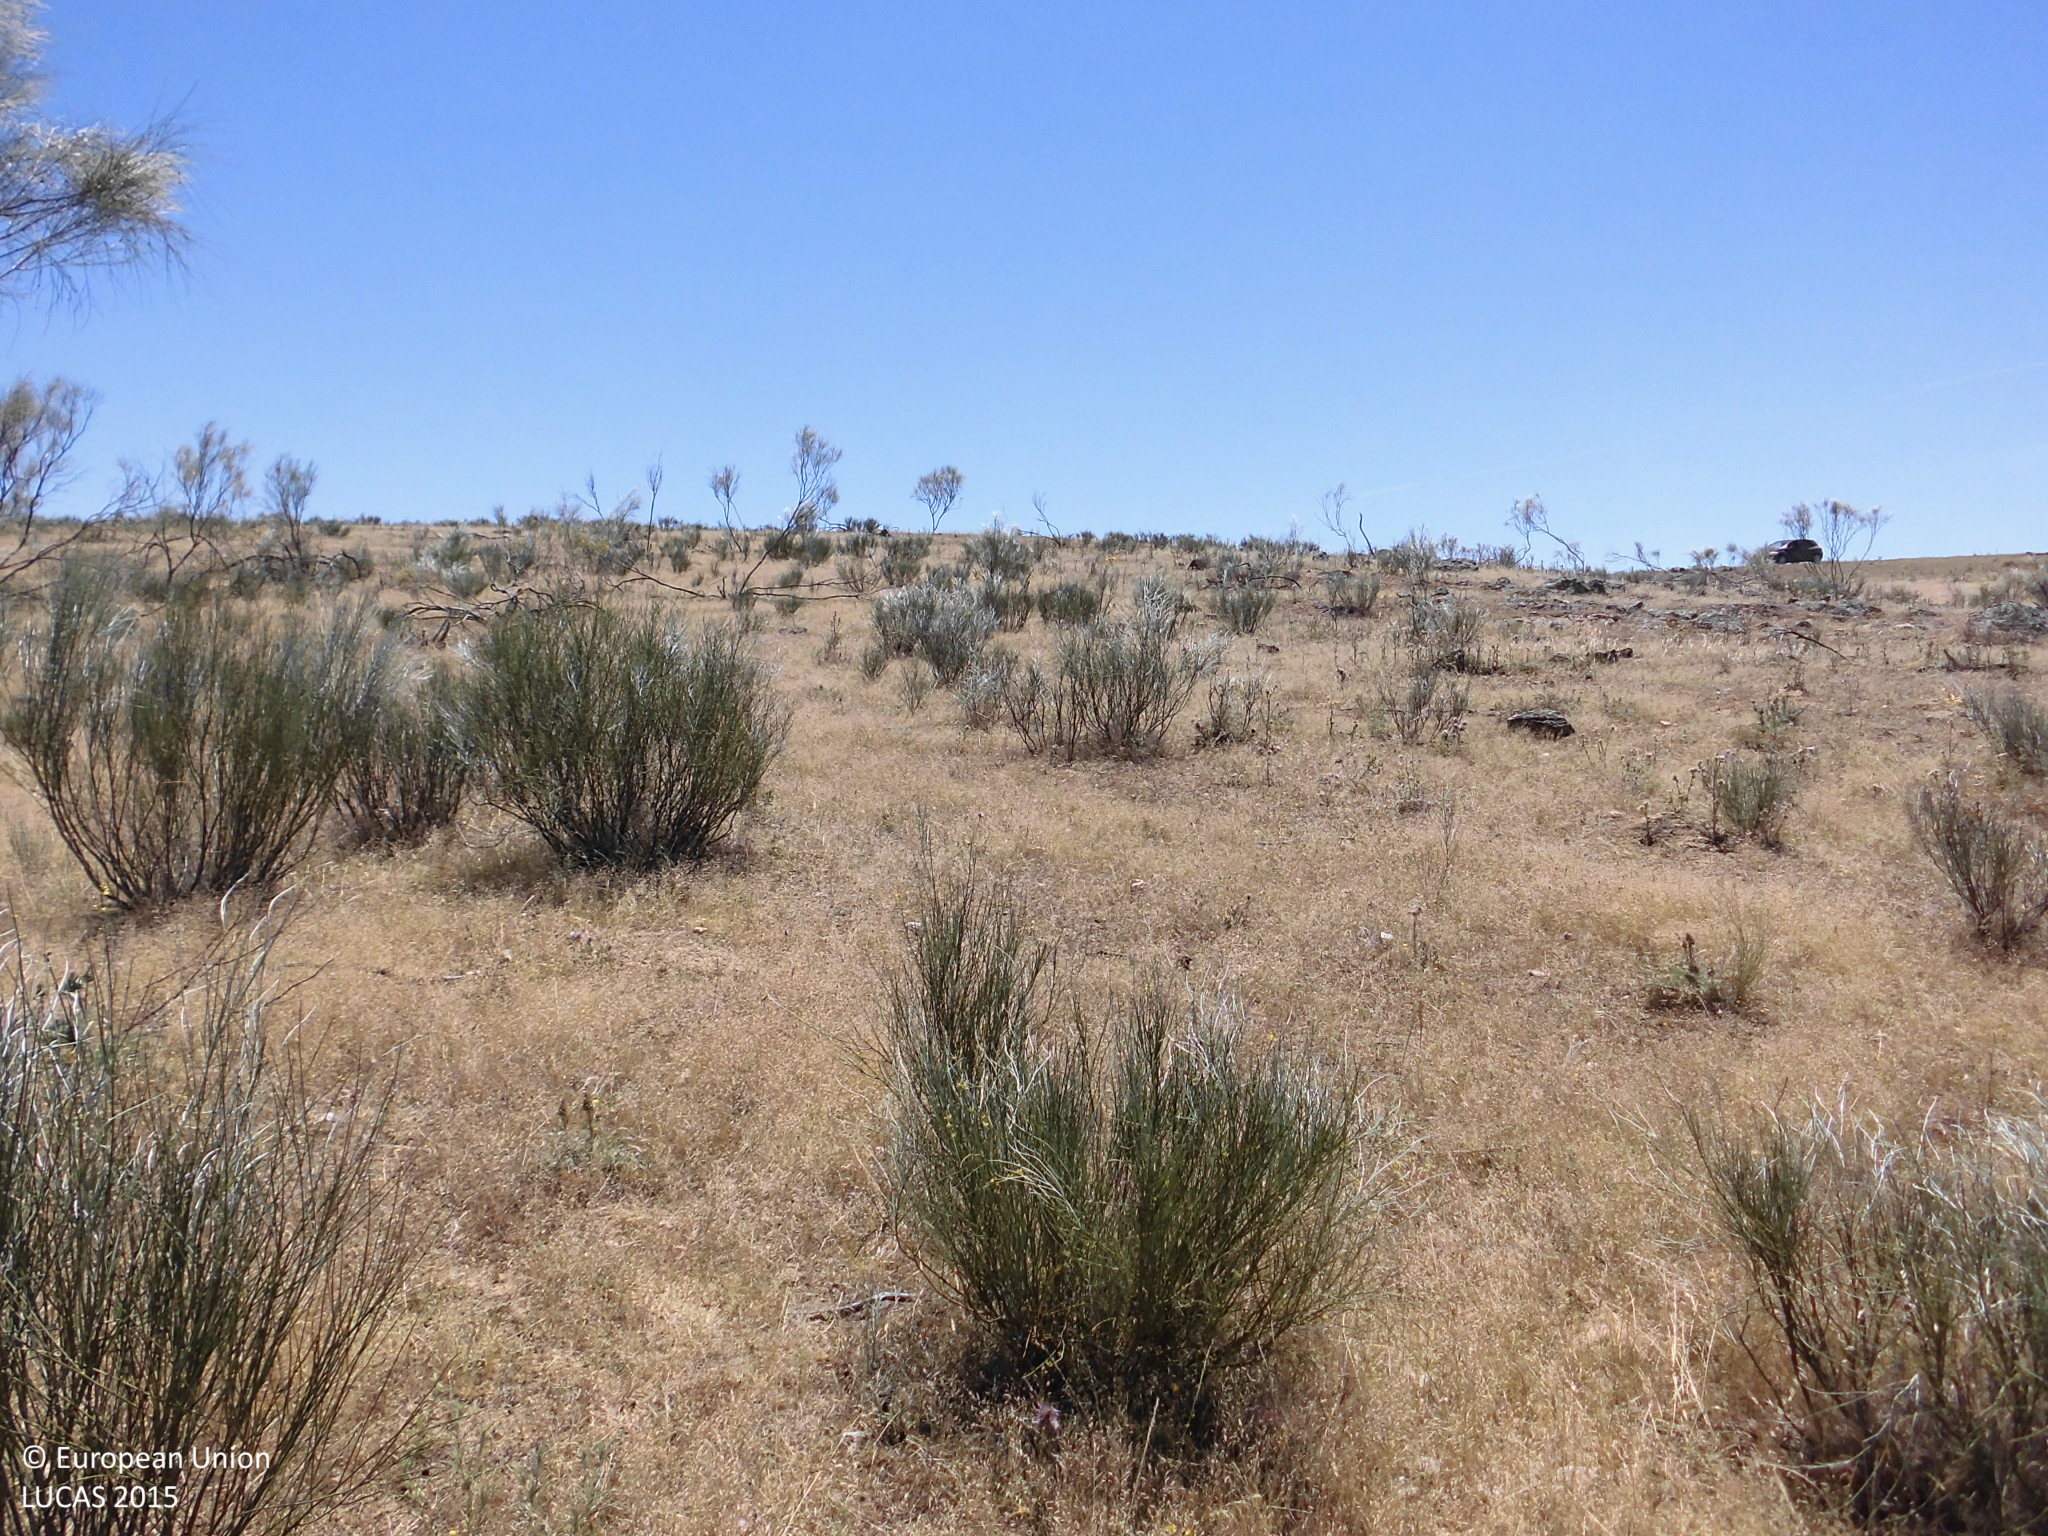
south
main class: Shrubland
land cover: Shrubland without tree cover
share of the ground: 10 - 25 %
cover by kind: herbaceous plants 85 %, shrubs 15 %
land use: Agriculture (excluding fallow land and kitchen gardens)
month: May
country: ES
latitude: 39.4852
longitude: -6.9266
